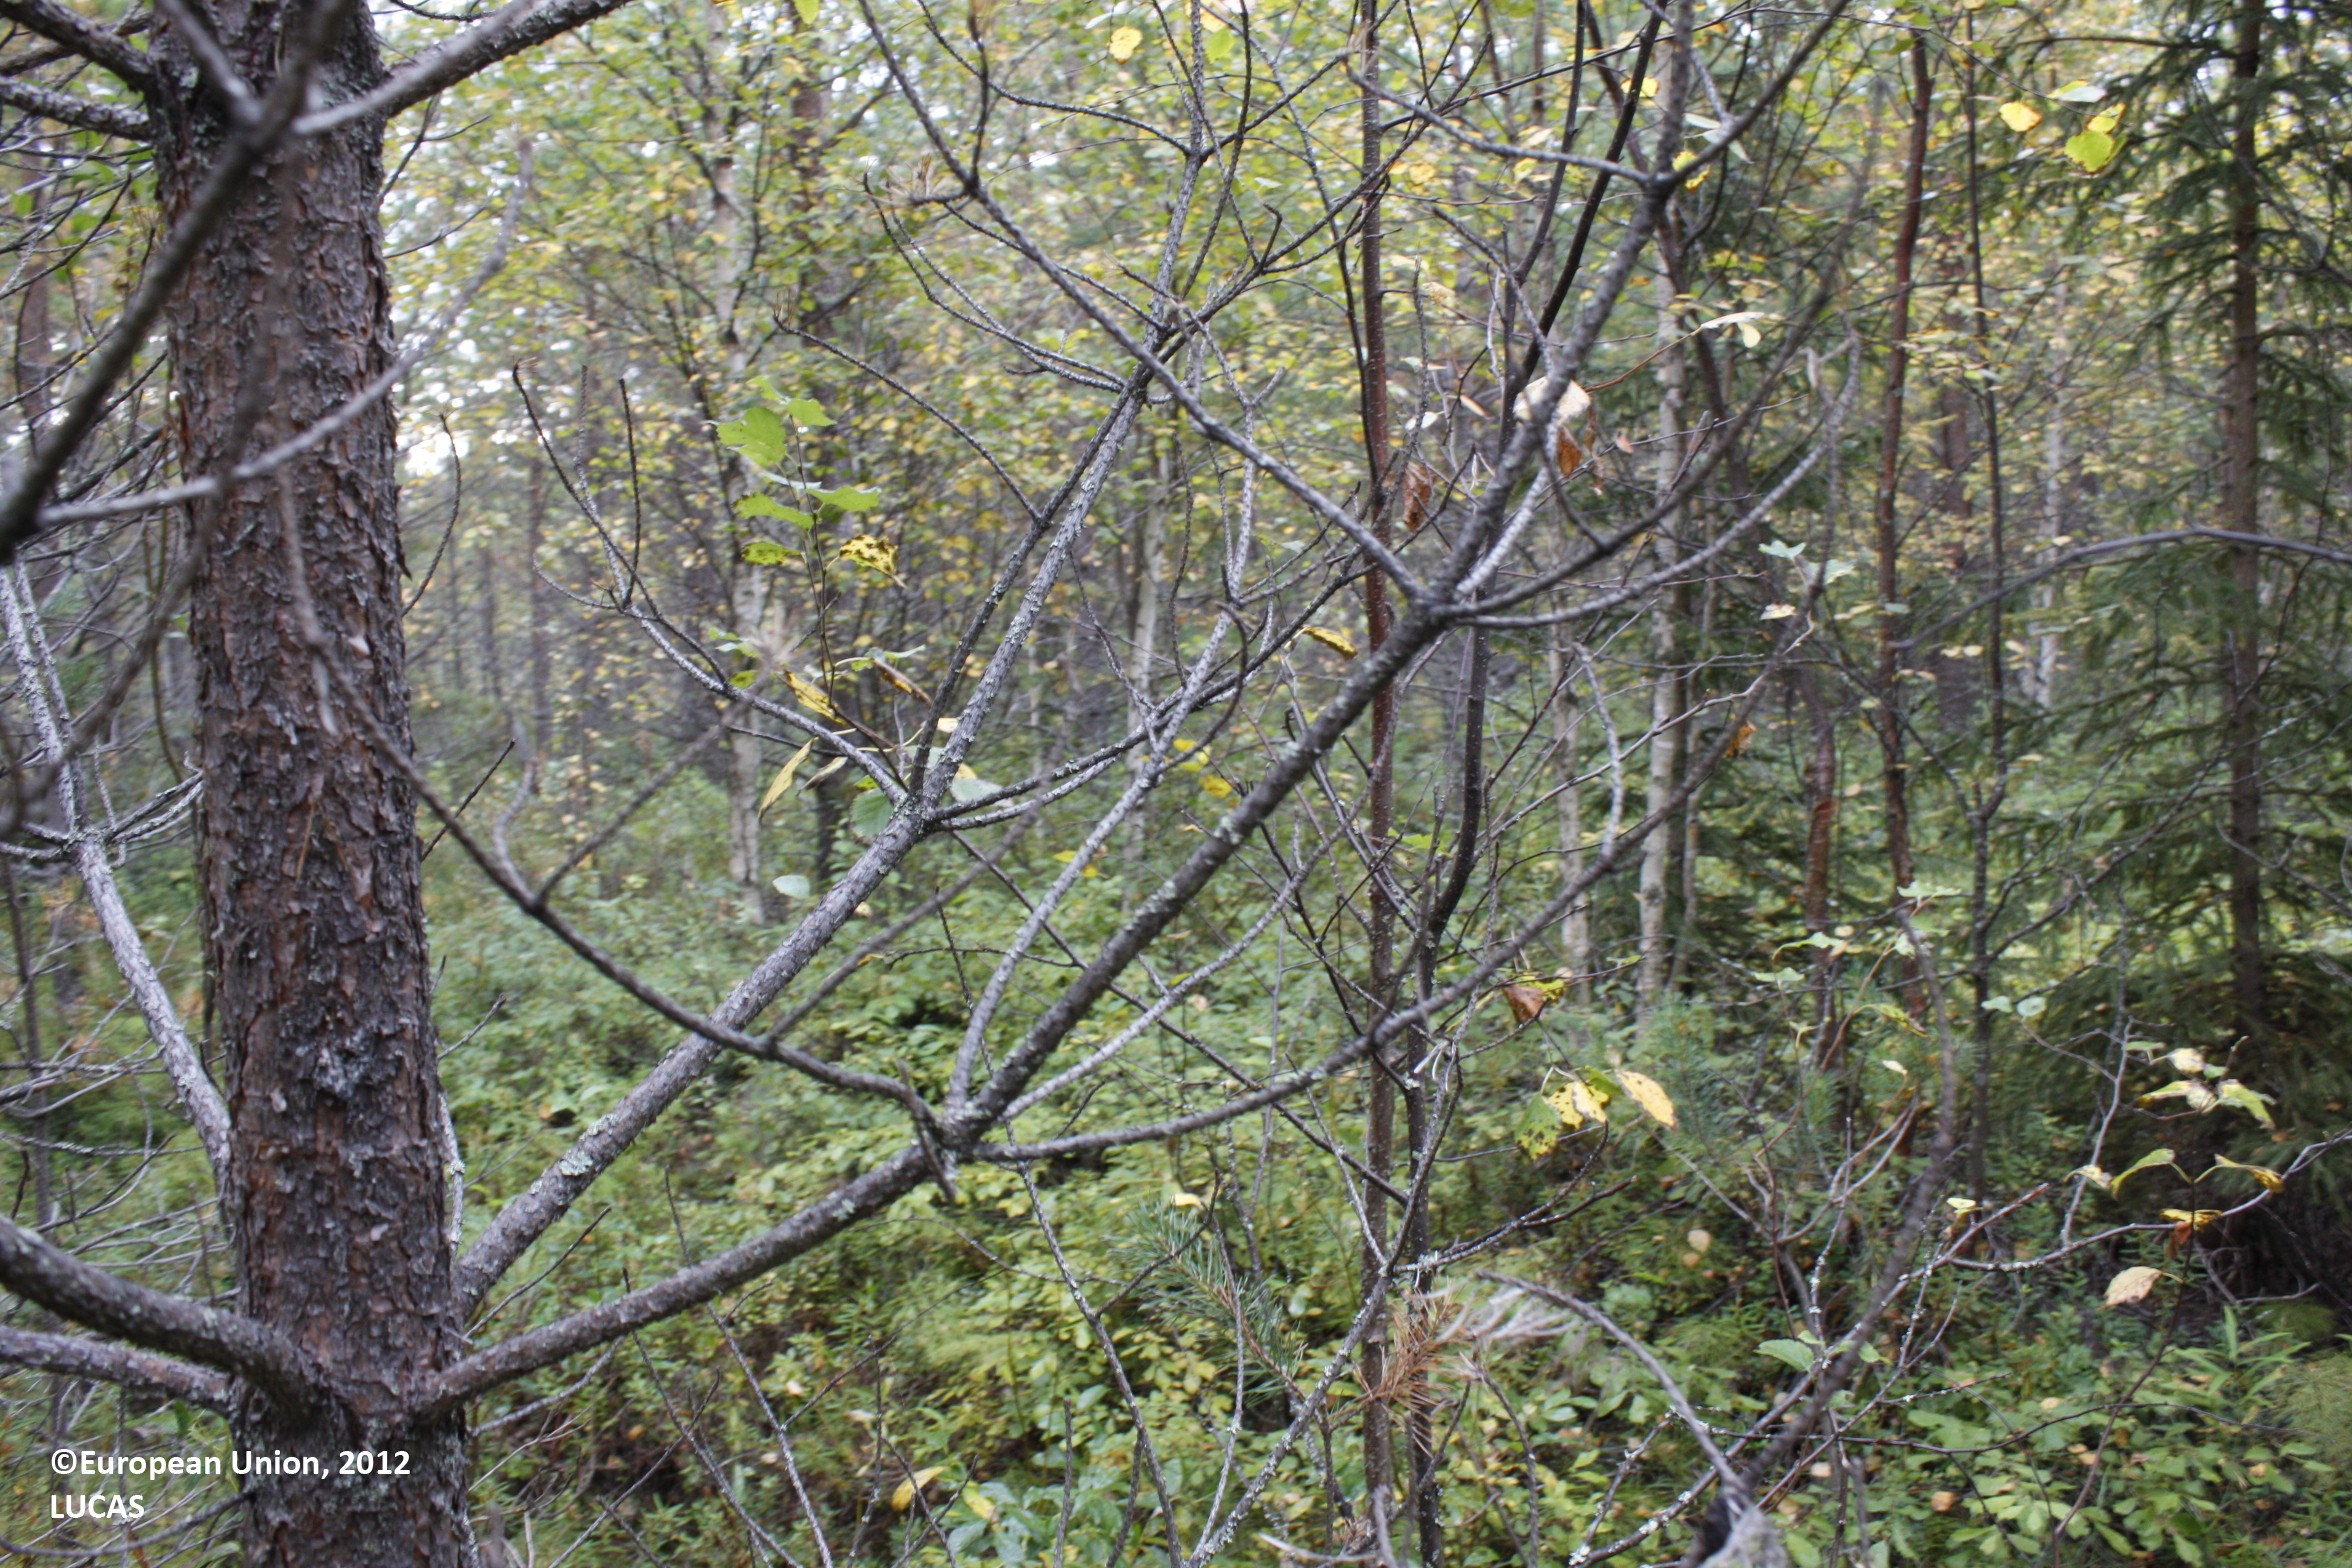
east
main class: Woodland
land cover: Pine dominated mixed woodland
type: mire and swamp forests
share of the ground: > 75 %
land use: Forestry
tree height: > 5 m
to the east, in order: Pine dominated mixed woodland; Ditches and canals; Pine dominated mixed woodland; Ditches and canals; Pine dominated mixed woodland; Ditches and canals; Pine dominated mixed woodland; Ditches and canals; Pine dominated mixed woodland; Ditches and canals; Pine dominated mixed woodland
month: September
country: FI
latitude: 65.3666
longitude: 26.8184
